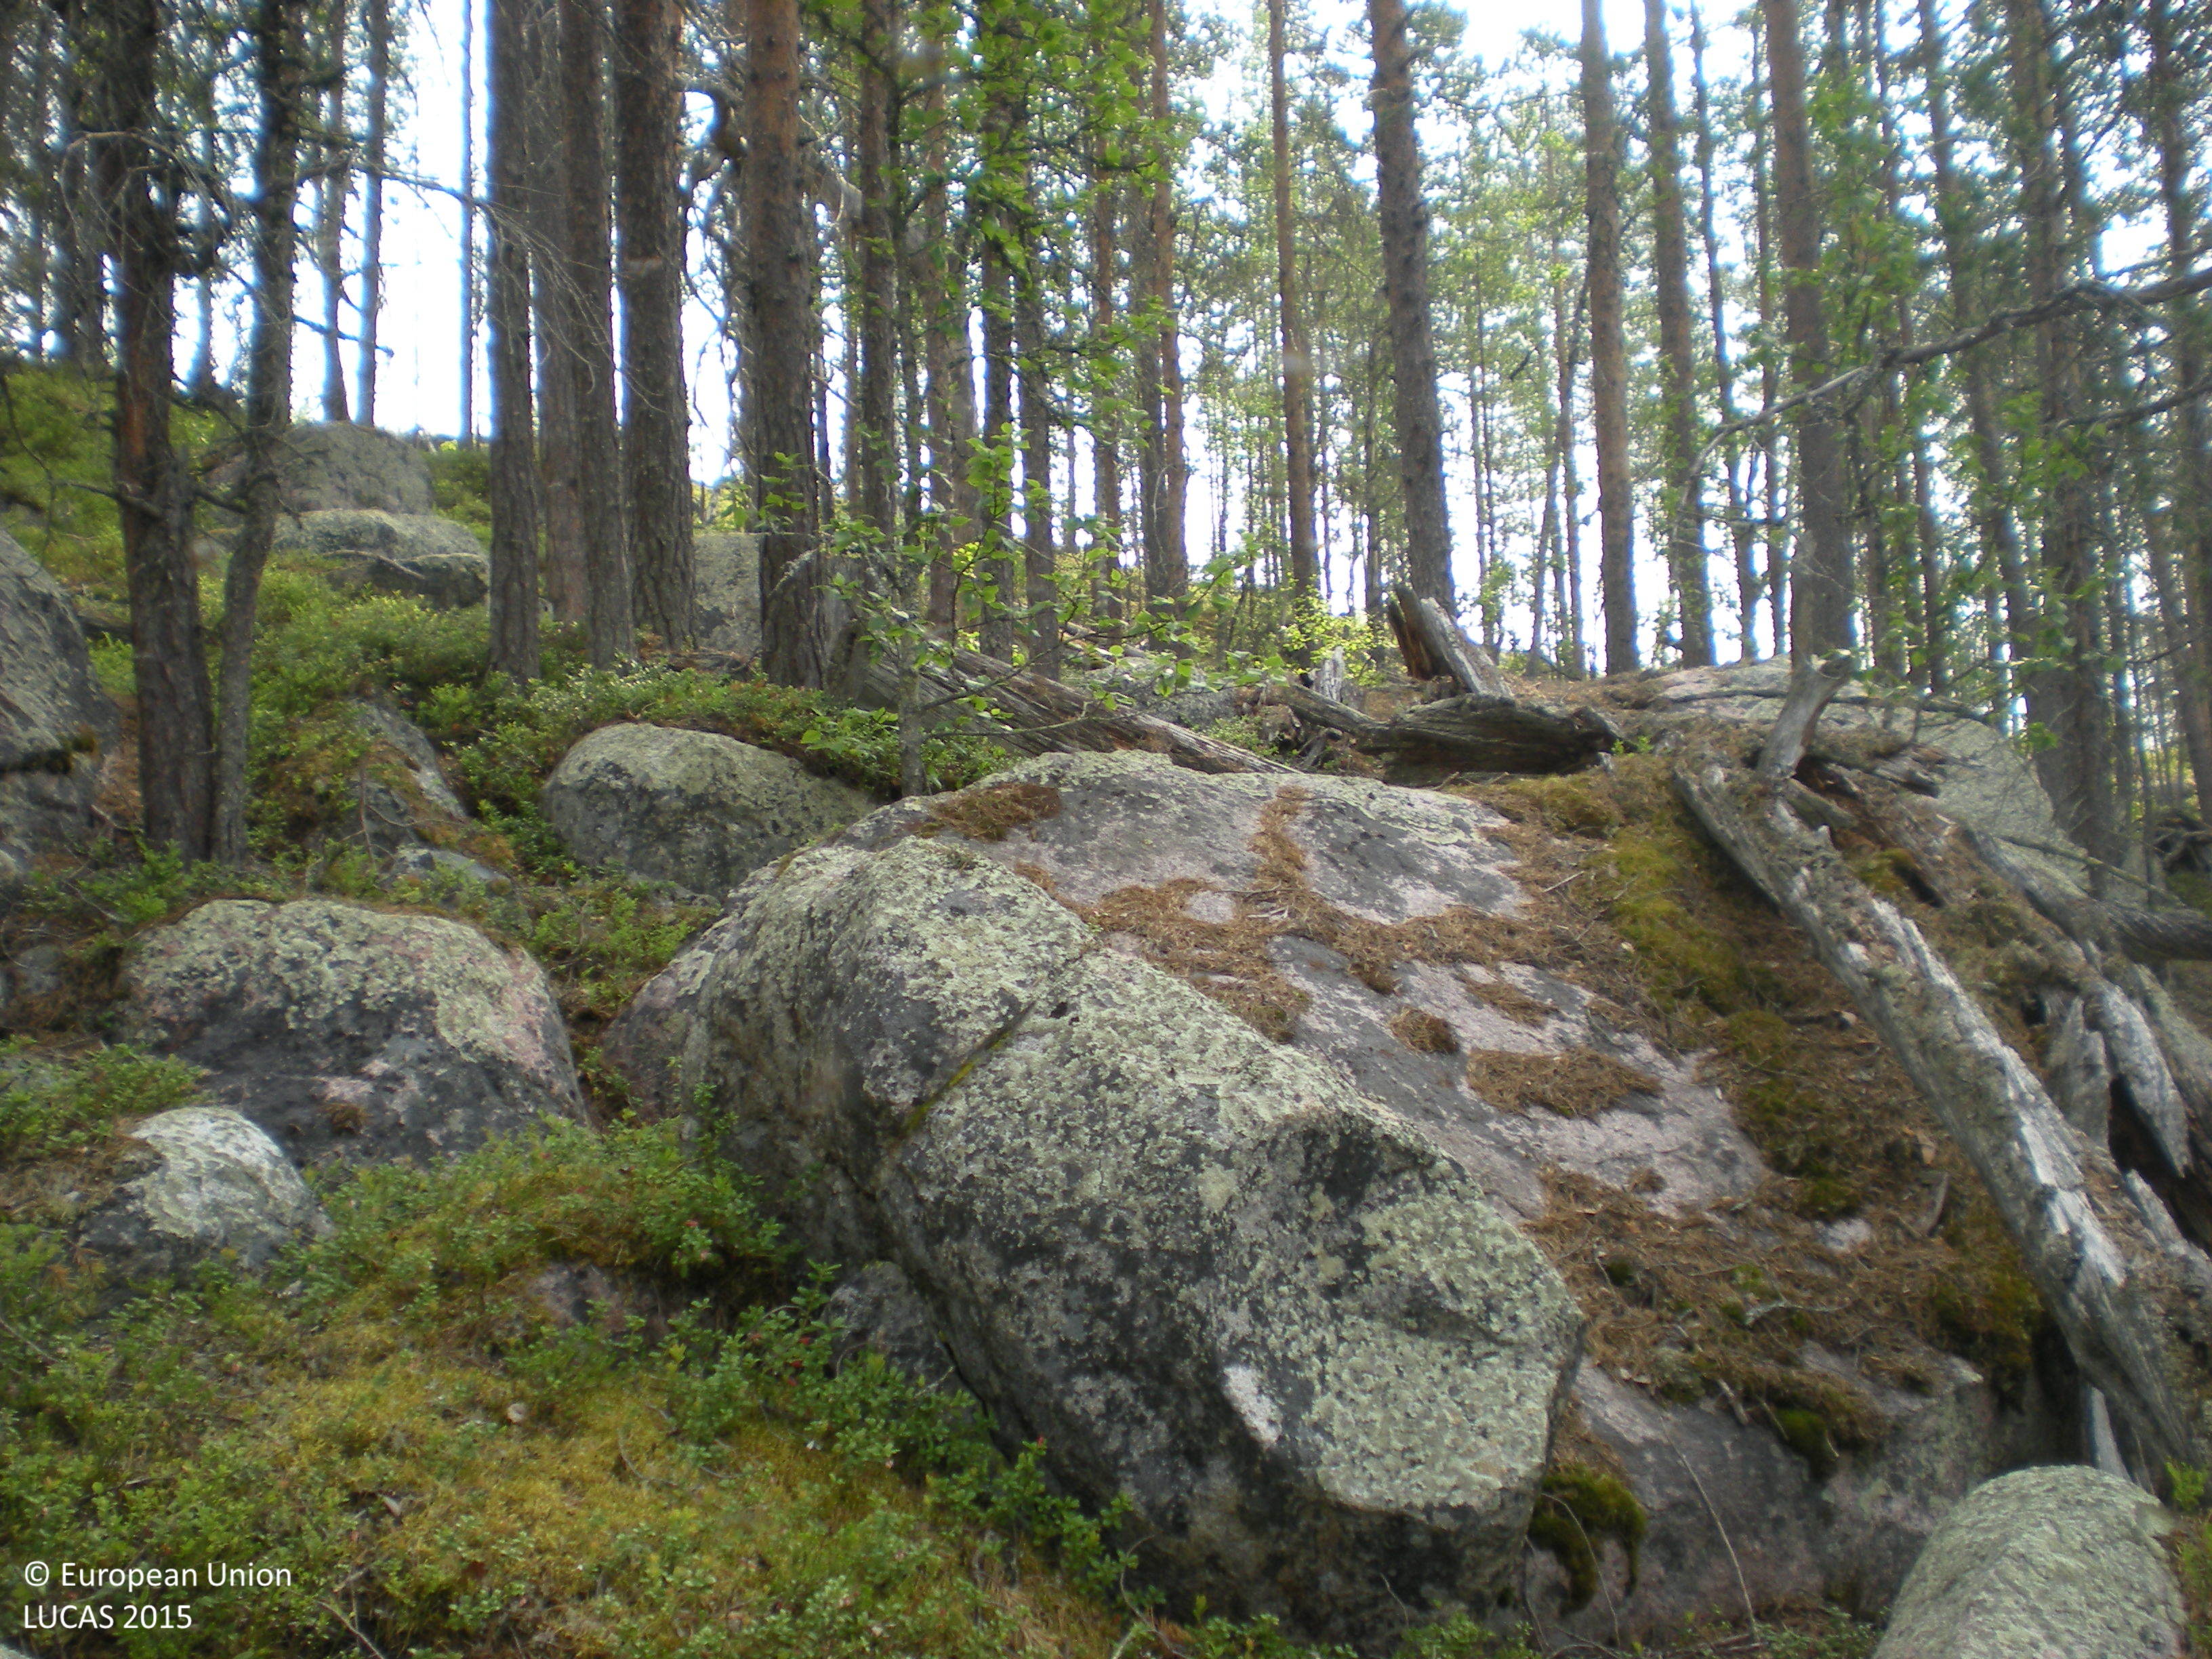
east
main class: Woodland
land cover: Pine dominated coniferous woodland
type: boreal forest
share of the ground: 50 - 75 %
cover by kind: coniferous forest trees 55 %, consolidated bare surface 30 %, shrubs 10 %, lichens and mosses 5 %
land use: Forestry
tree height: > 5 m
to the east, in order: Pine dominated coniferous woodland; Shrubland with sparse tree cover; Other mixed woodland
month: July
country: SE
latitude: 65.2708
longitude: 17.5669
